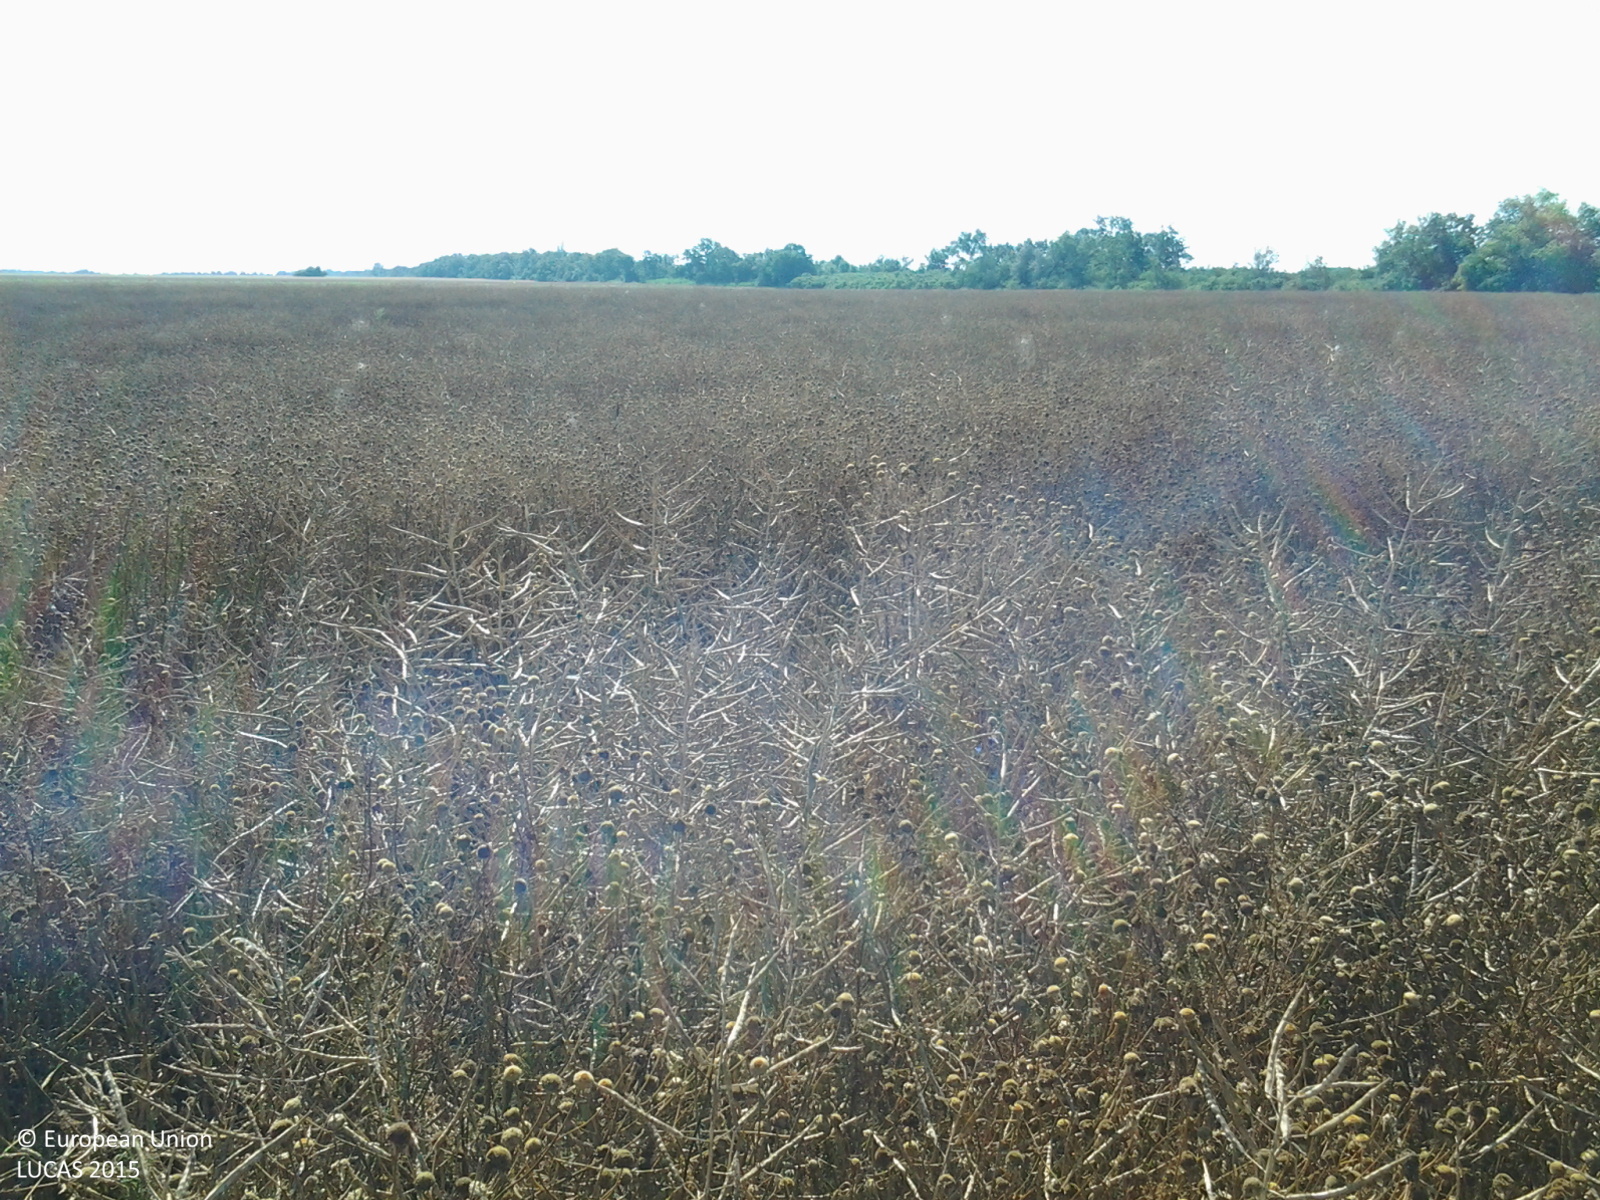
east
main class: Cropland
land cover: Rape and turnip rape
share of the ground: > 75 %
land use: Agriculture (excluding fallow land and kitchen gardens)
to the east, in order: Rape and turnip rape; Sunflower; Common wheat; Grass margins; Grassland without tree/shrub cover
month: July
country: HU
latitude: 47.0168
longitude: 20.4606
